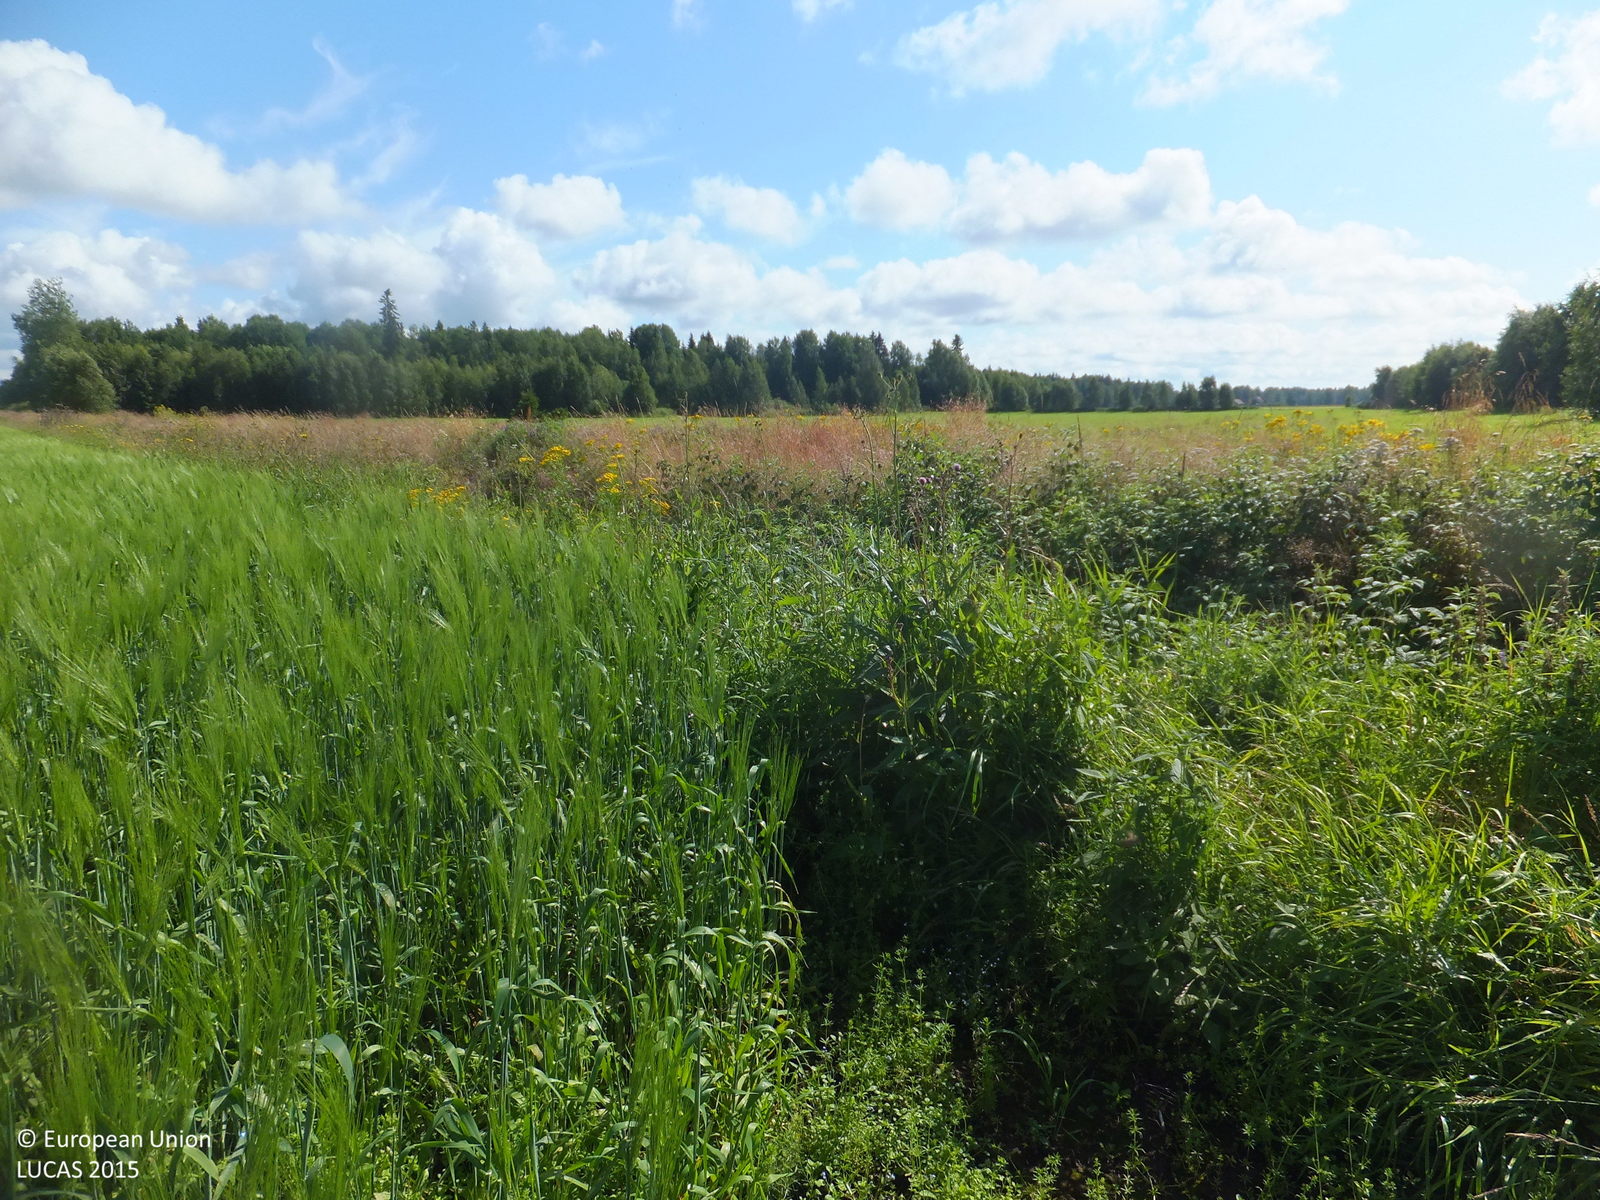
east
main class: Cropland
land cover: Barley
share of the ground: > 75 %
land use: Agriculture (excluding fallow land and kitchen gardens)
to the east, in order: Barley; Grass margins; Ditches and canals; Grass margins; Paved roads, cycling and walking lanes; Grass margins; Ditches and canals; Temporary grasslands; Broadleaved woodland; Ditches and canals; Oats
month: July
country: FI
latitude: 63.0639
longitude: 22.2163
